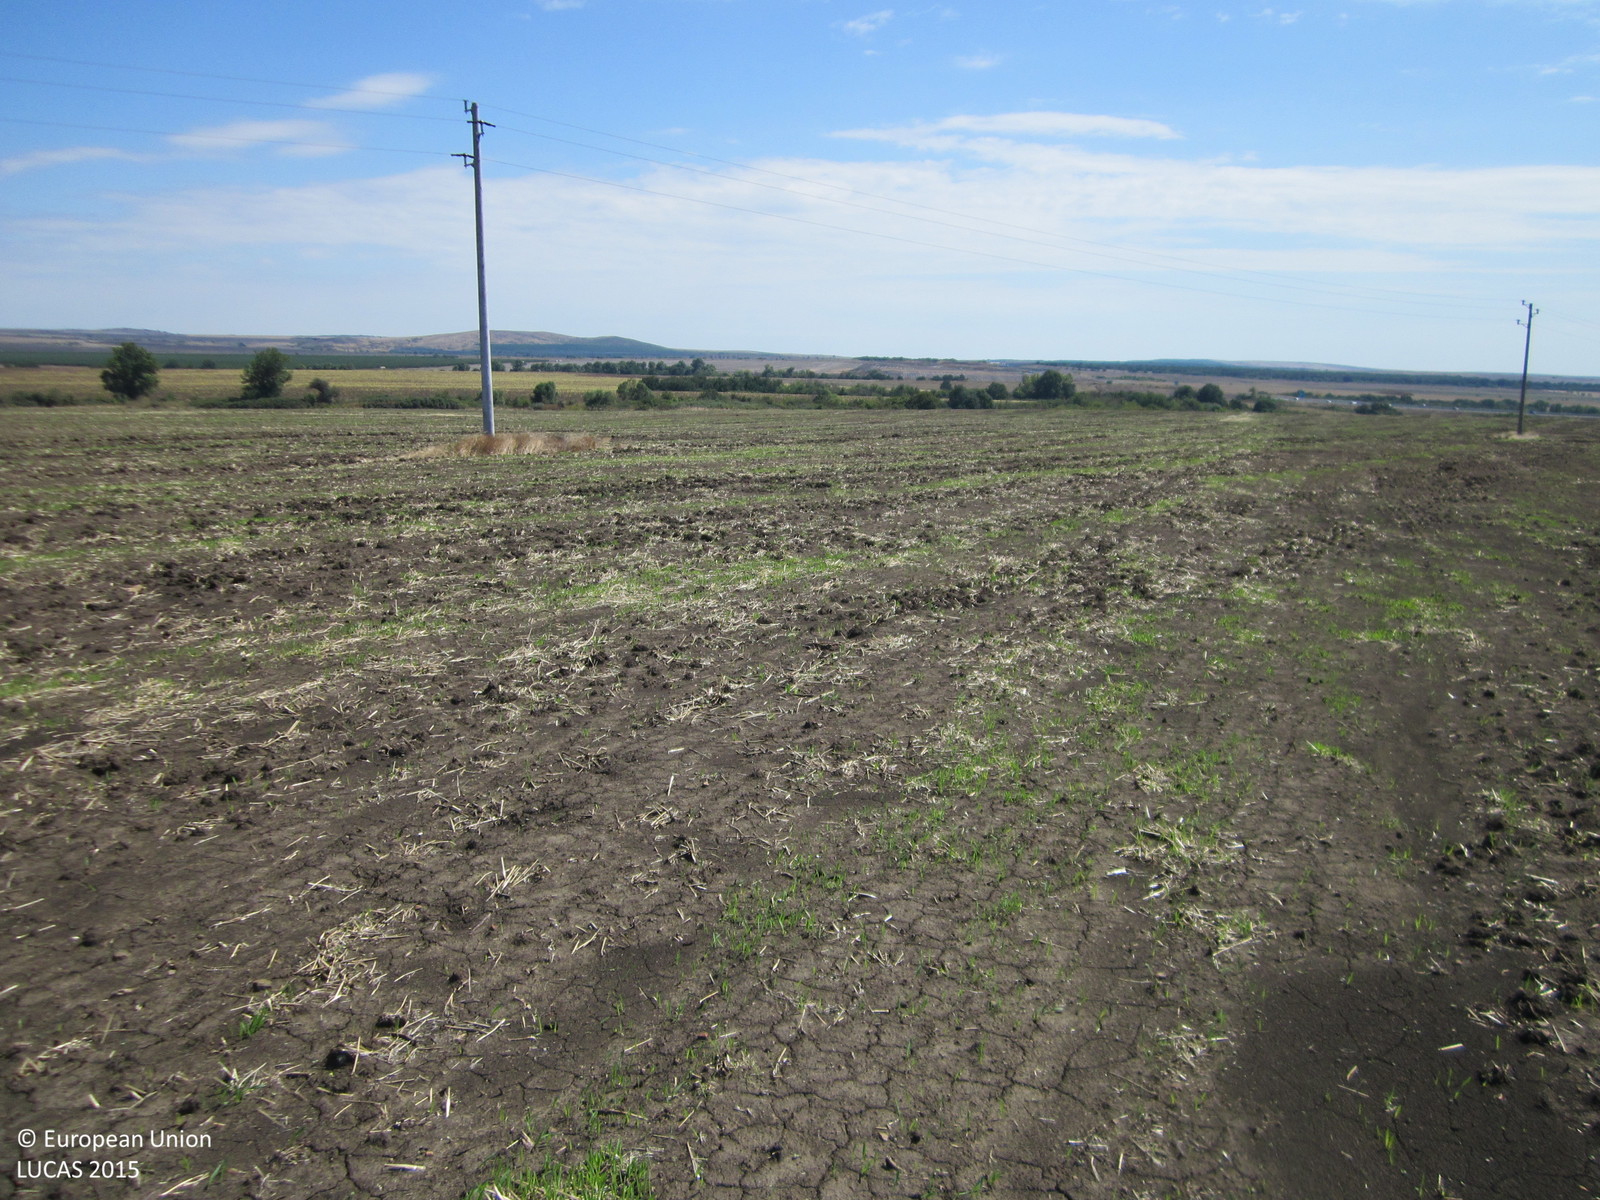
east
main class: Cropland
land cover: Common wheat
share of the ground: < 10 %
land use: Agriculture (excluding fallow land and kitchen gardens)
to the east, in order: Common wheat; Electric lines; Common wheat
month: August
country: BG
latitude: 42.5925
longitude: 26.9587
